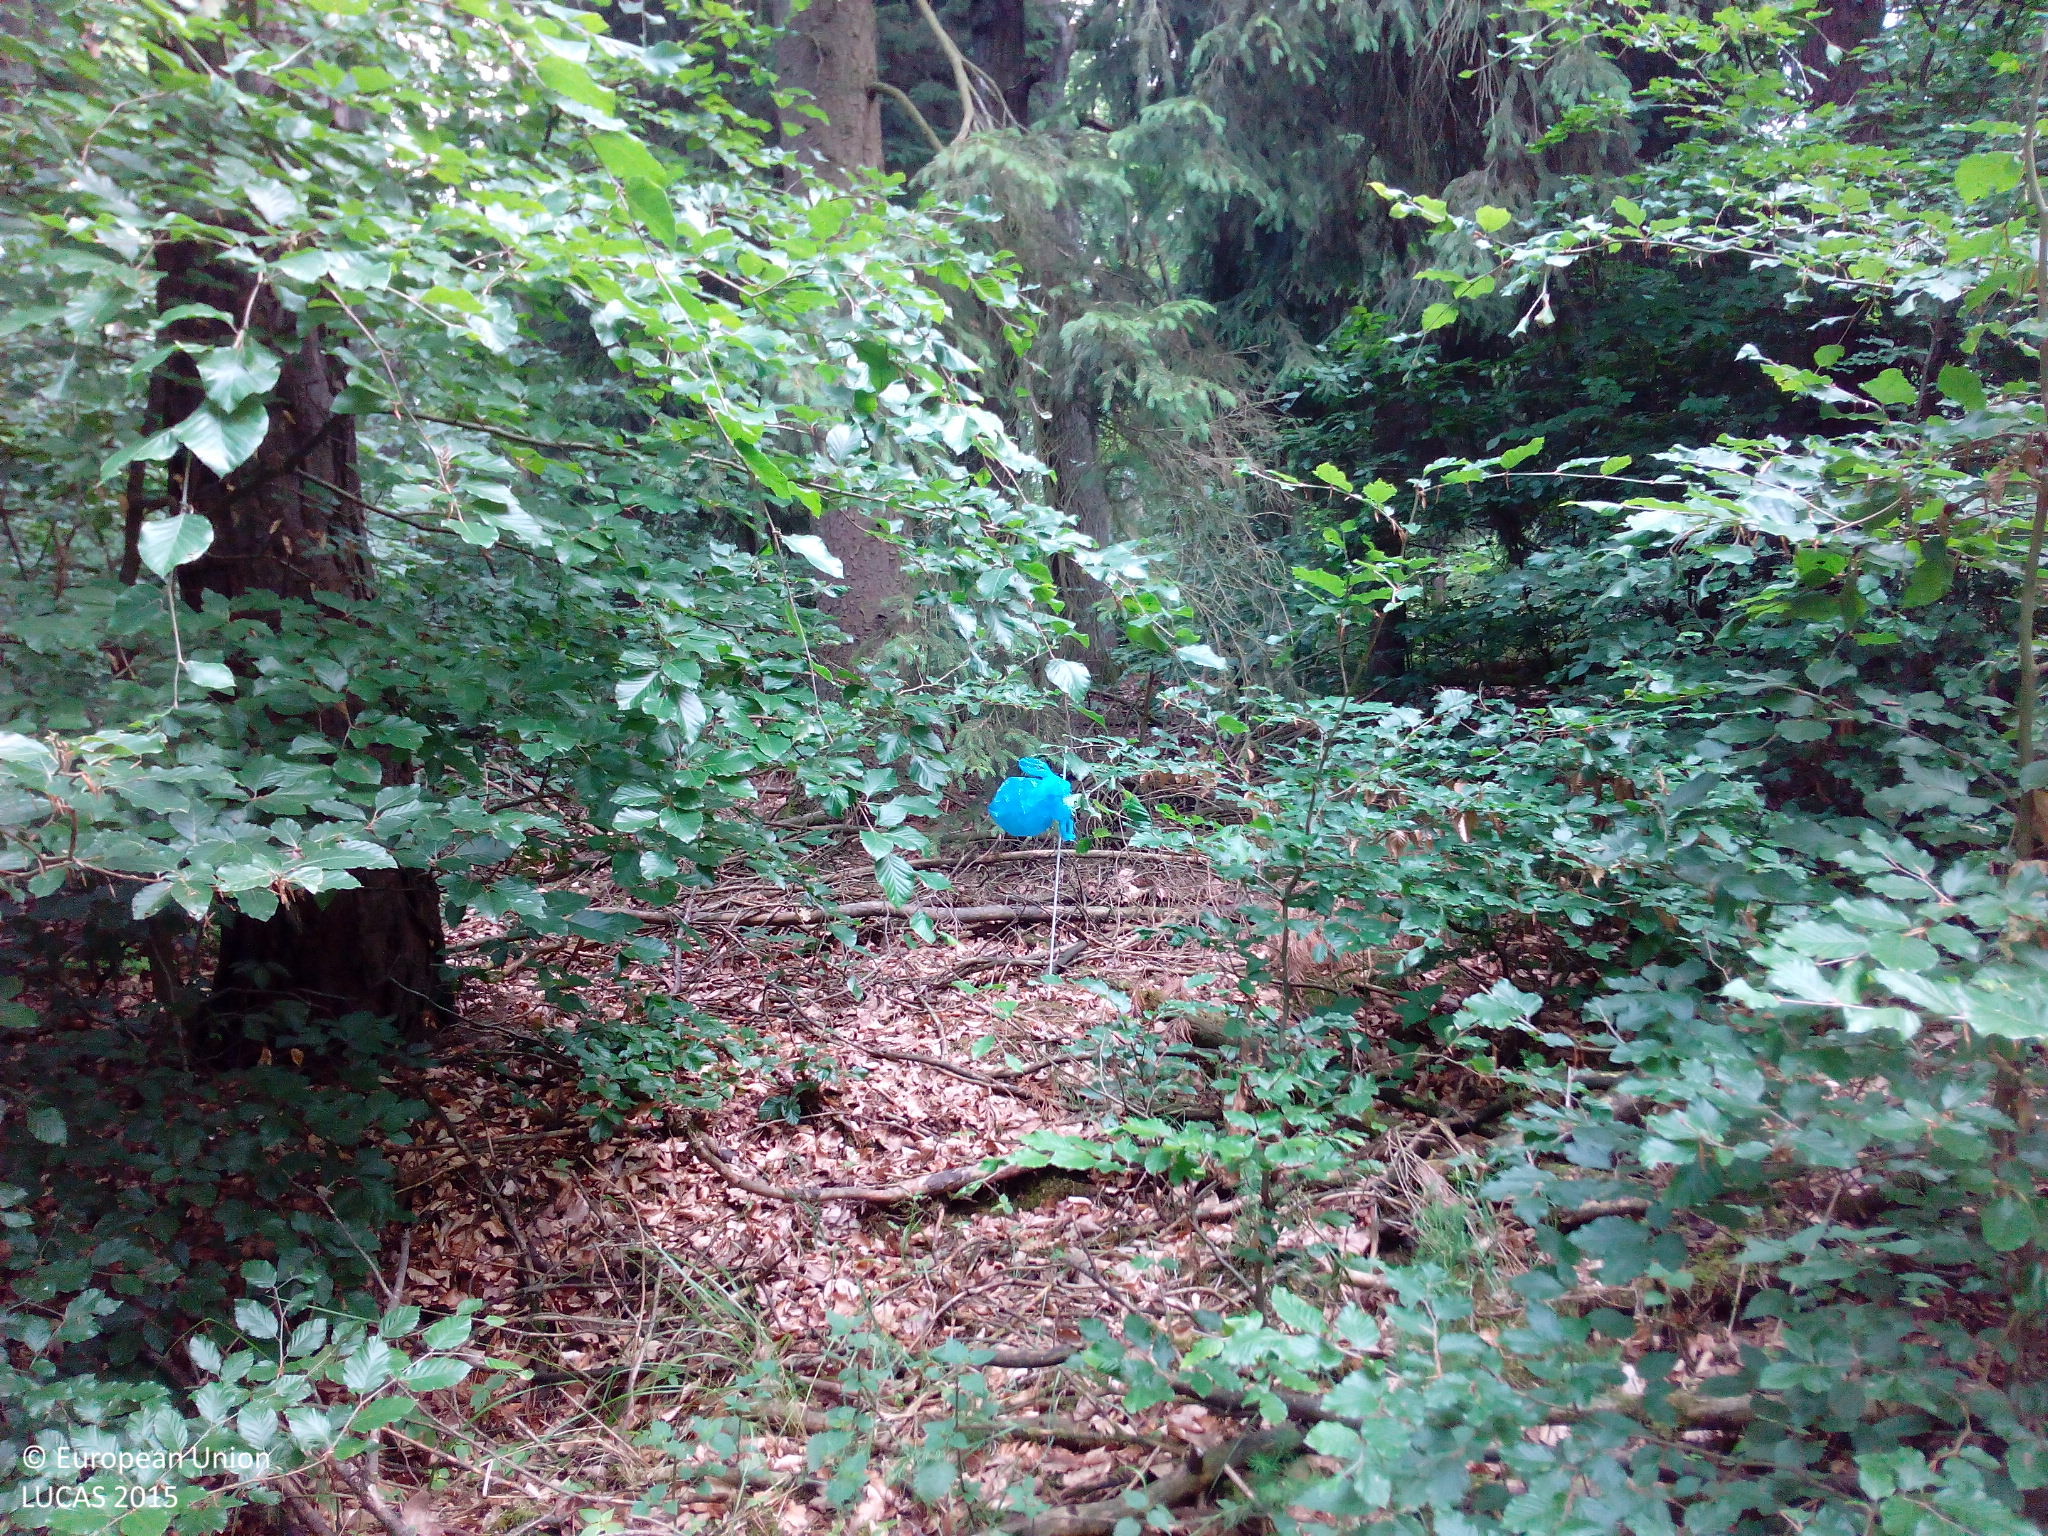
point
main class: Woodland
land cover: Other mixed woodland
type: hemiboreal forest and nemoral coniferous forest and mixed broadleaved-coniferous forest
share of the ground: > 75 %
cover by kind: broadleaved forest trees 60 %, coniferous forest trees 30 %, herbaceous plants 5 %, unconsolidated bare surface 5 %
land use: Forestry
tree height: > 5 m
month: June
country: DE
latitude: 52.0851
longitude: 12.3200
